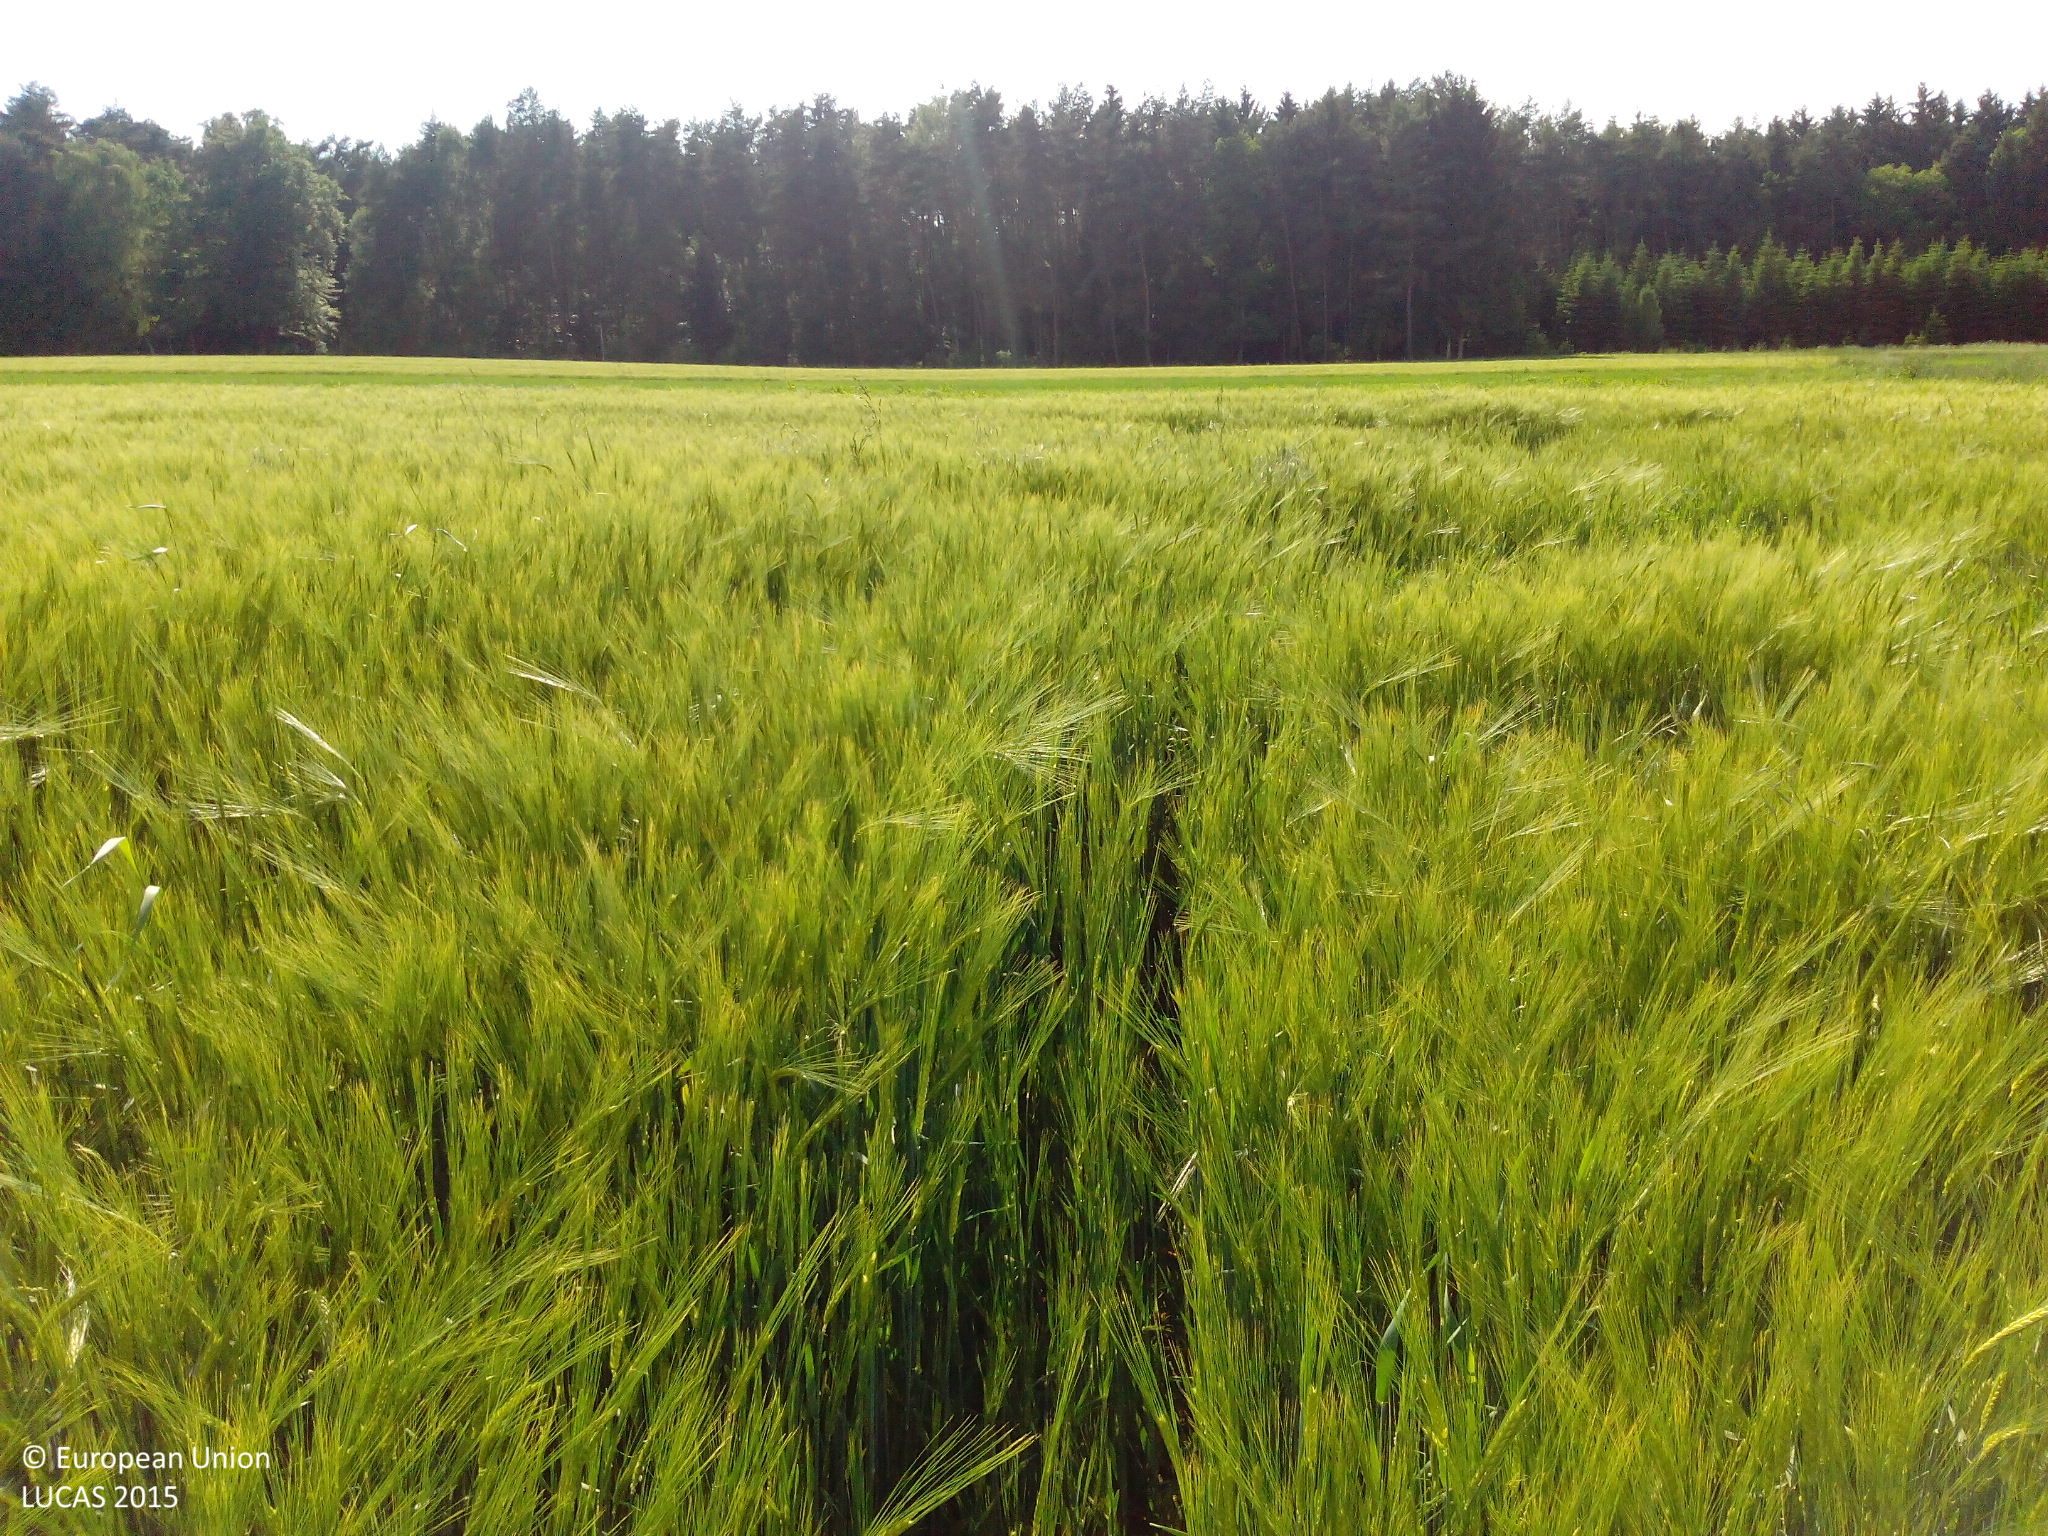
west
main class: Cropland
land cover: Barley
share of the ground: > 75 %
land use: Agriculture (excluding fallow land and kitchen gardens)
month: June
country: DE
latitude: 48.8158
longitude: 12.0829
